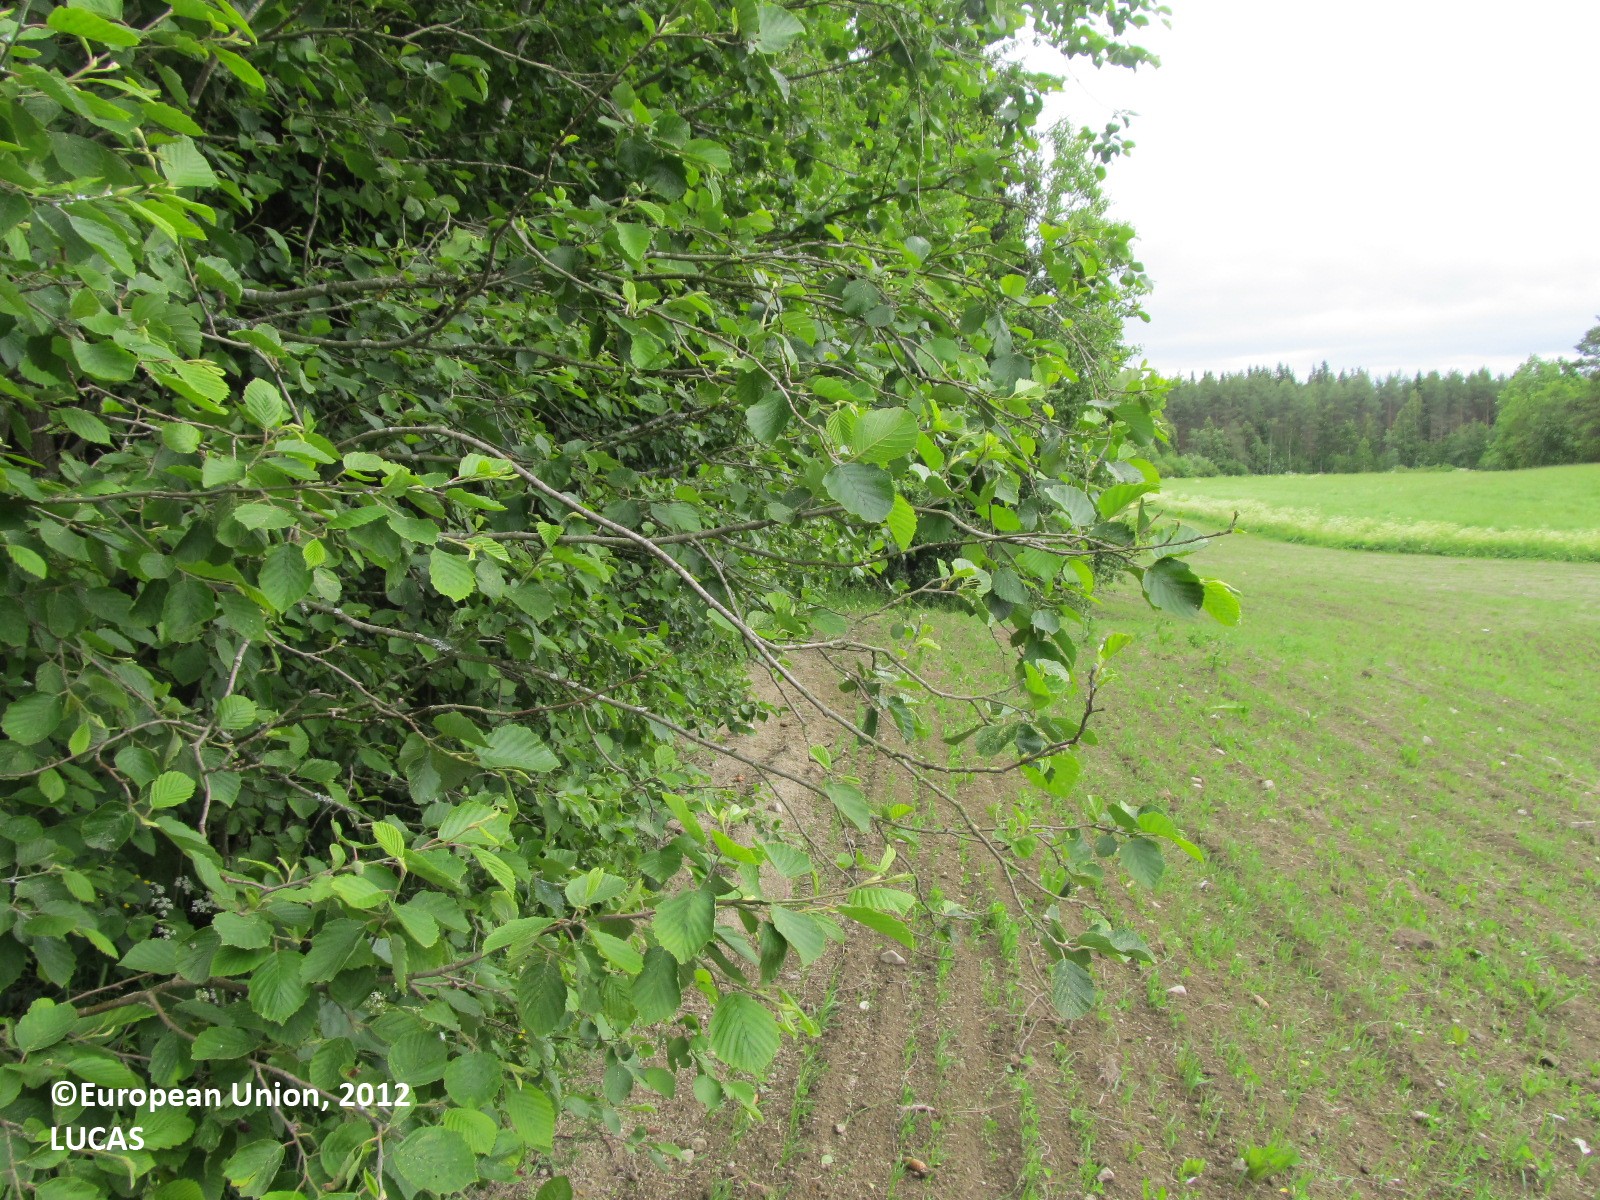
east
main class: Cropland
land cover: Oats
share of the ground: 10 - 25 %
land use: Agriculture (excluding fallow land and kitchen gardens)
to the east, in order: Oats; Ditches and canals; Broadleaved woodland; Fences; Broadleaved woodland; Grassland with sparse tree/shrub cover; Temporary grasslands
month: June
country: FI
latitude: 62.7500
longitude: 29.1126
